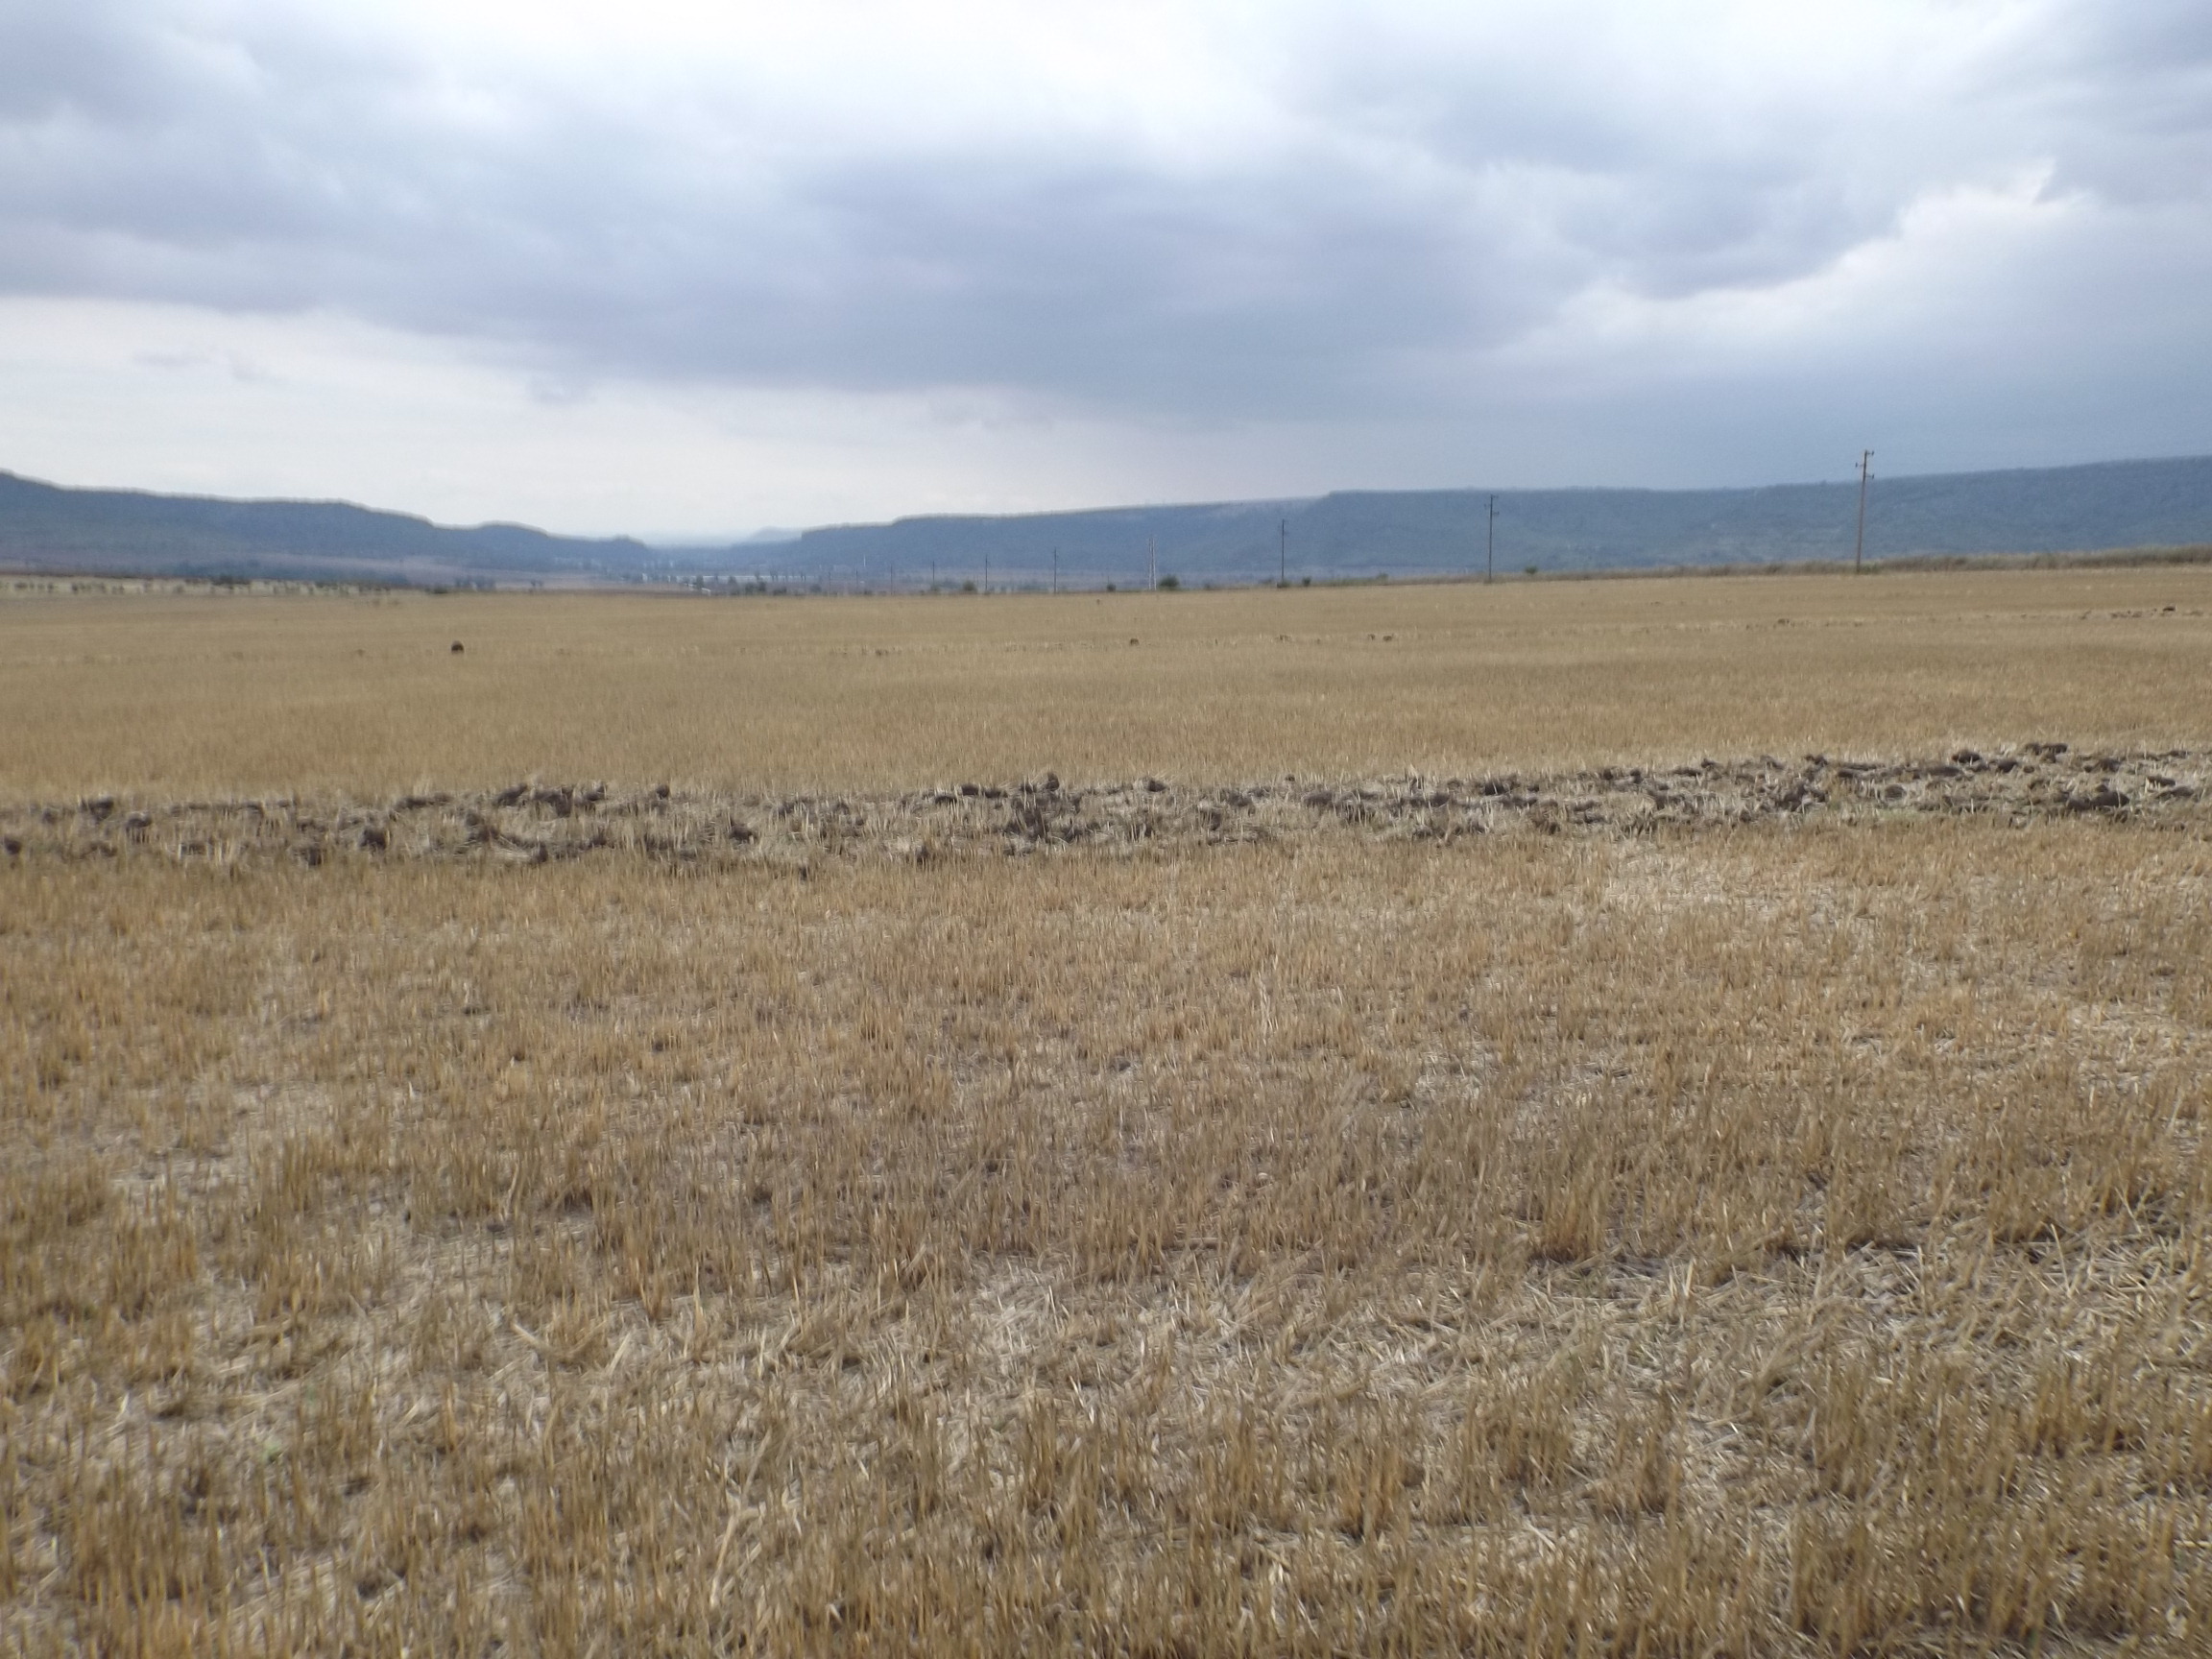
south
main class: Cropland
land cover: Common wheat
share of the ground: < 10 %
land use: Agriculture (excluding fallow land and kitchen gardens)
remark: Harvested field
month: August
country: BG
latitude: 43.2482
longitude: 27.4305
